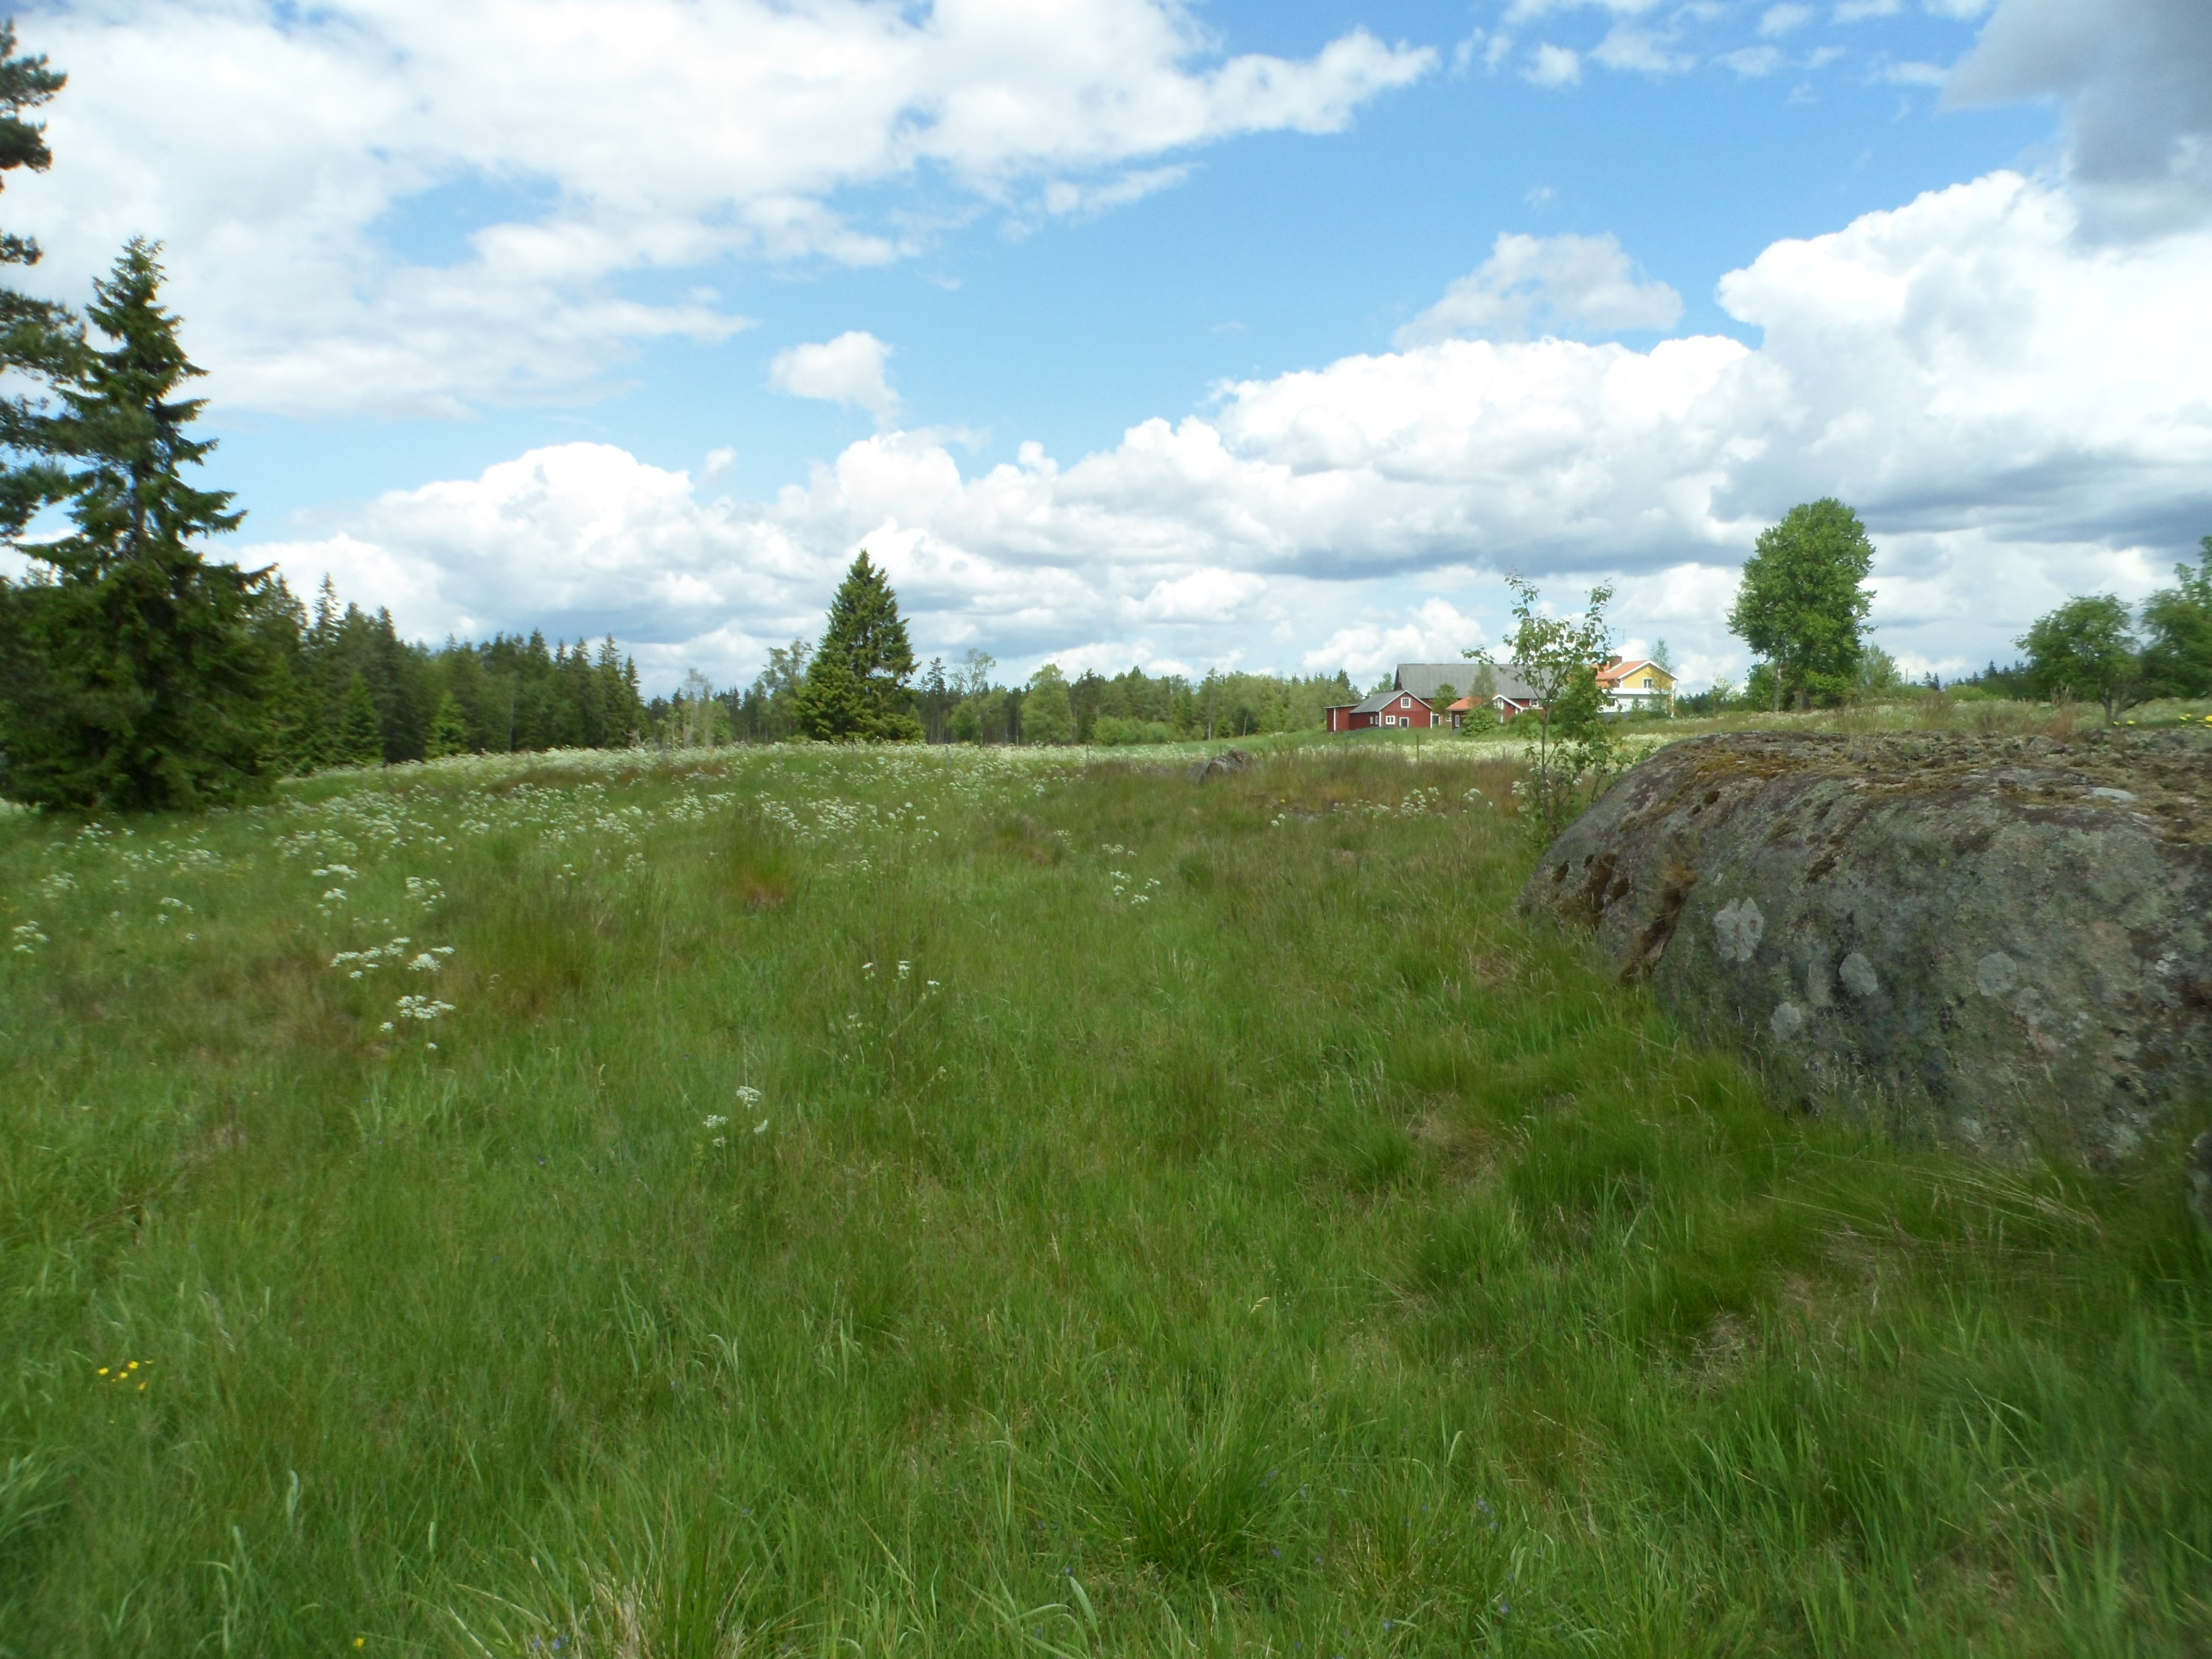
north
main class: Grassland
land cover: Grassland with sparse tree/shrub cover
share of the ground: > 75 %
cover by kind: herbaceous plants 90 %, broadleaved forest trees 5 %, shrubs 5 %
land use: Agriculture (excluding fallow land and kitchen gardens)
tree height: < 5 m
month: June
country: SE
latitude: 57.3086
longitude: 14.1626
